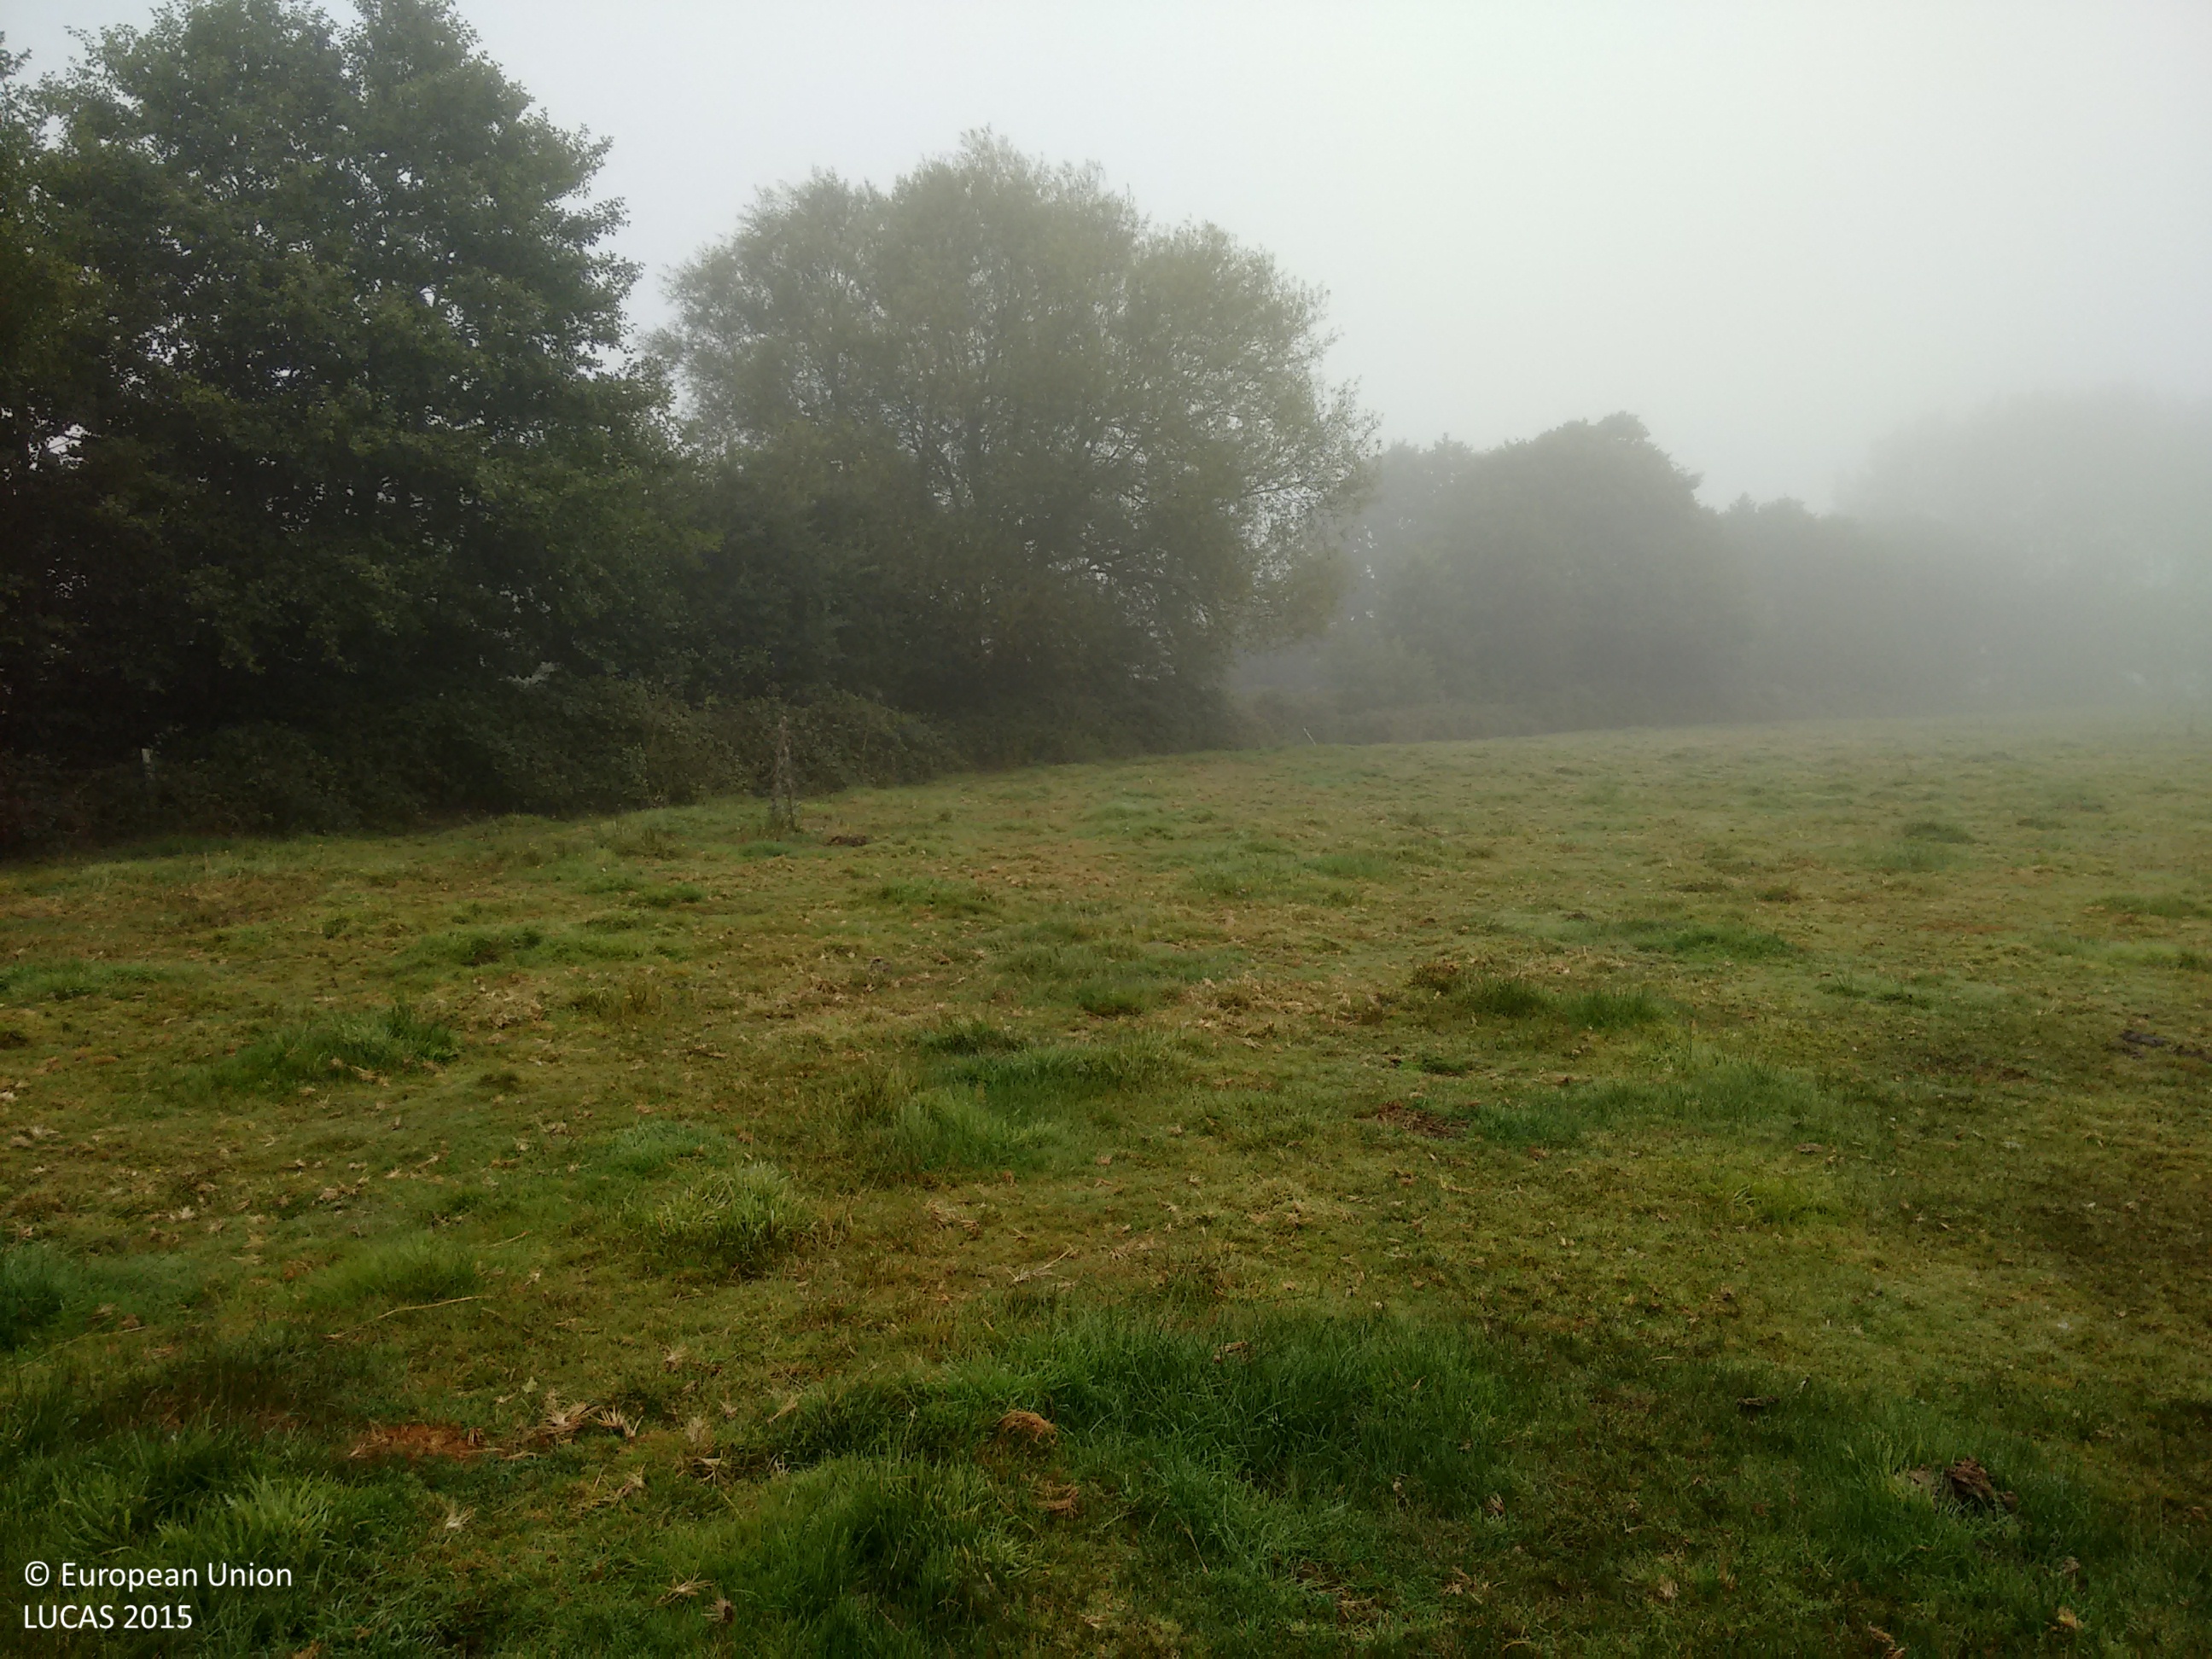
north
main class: Grassland
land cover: Grassland without tree/shrub cover
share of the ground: > 75 %
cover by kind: herbaceous plants 100 %
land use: Agriculture (excluding fallow land and kitchen gardens)
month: September
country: GB
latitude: 52.8135
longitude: -2.9371
